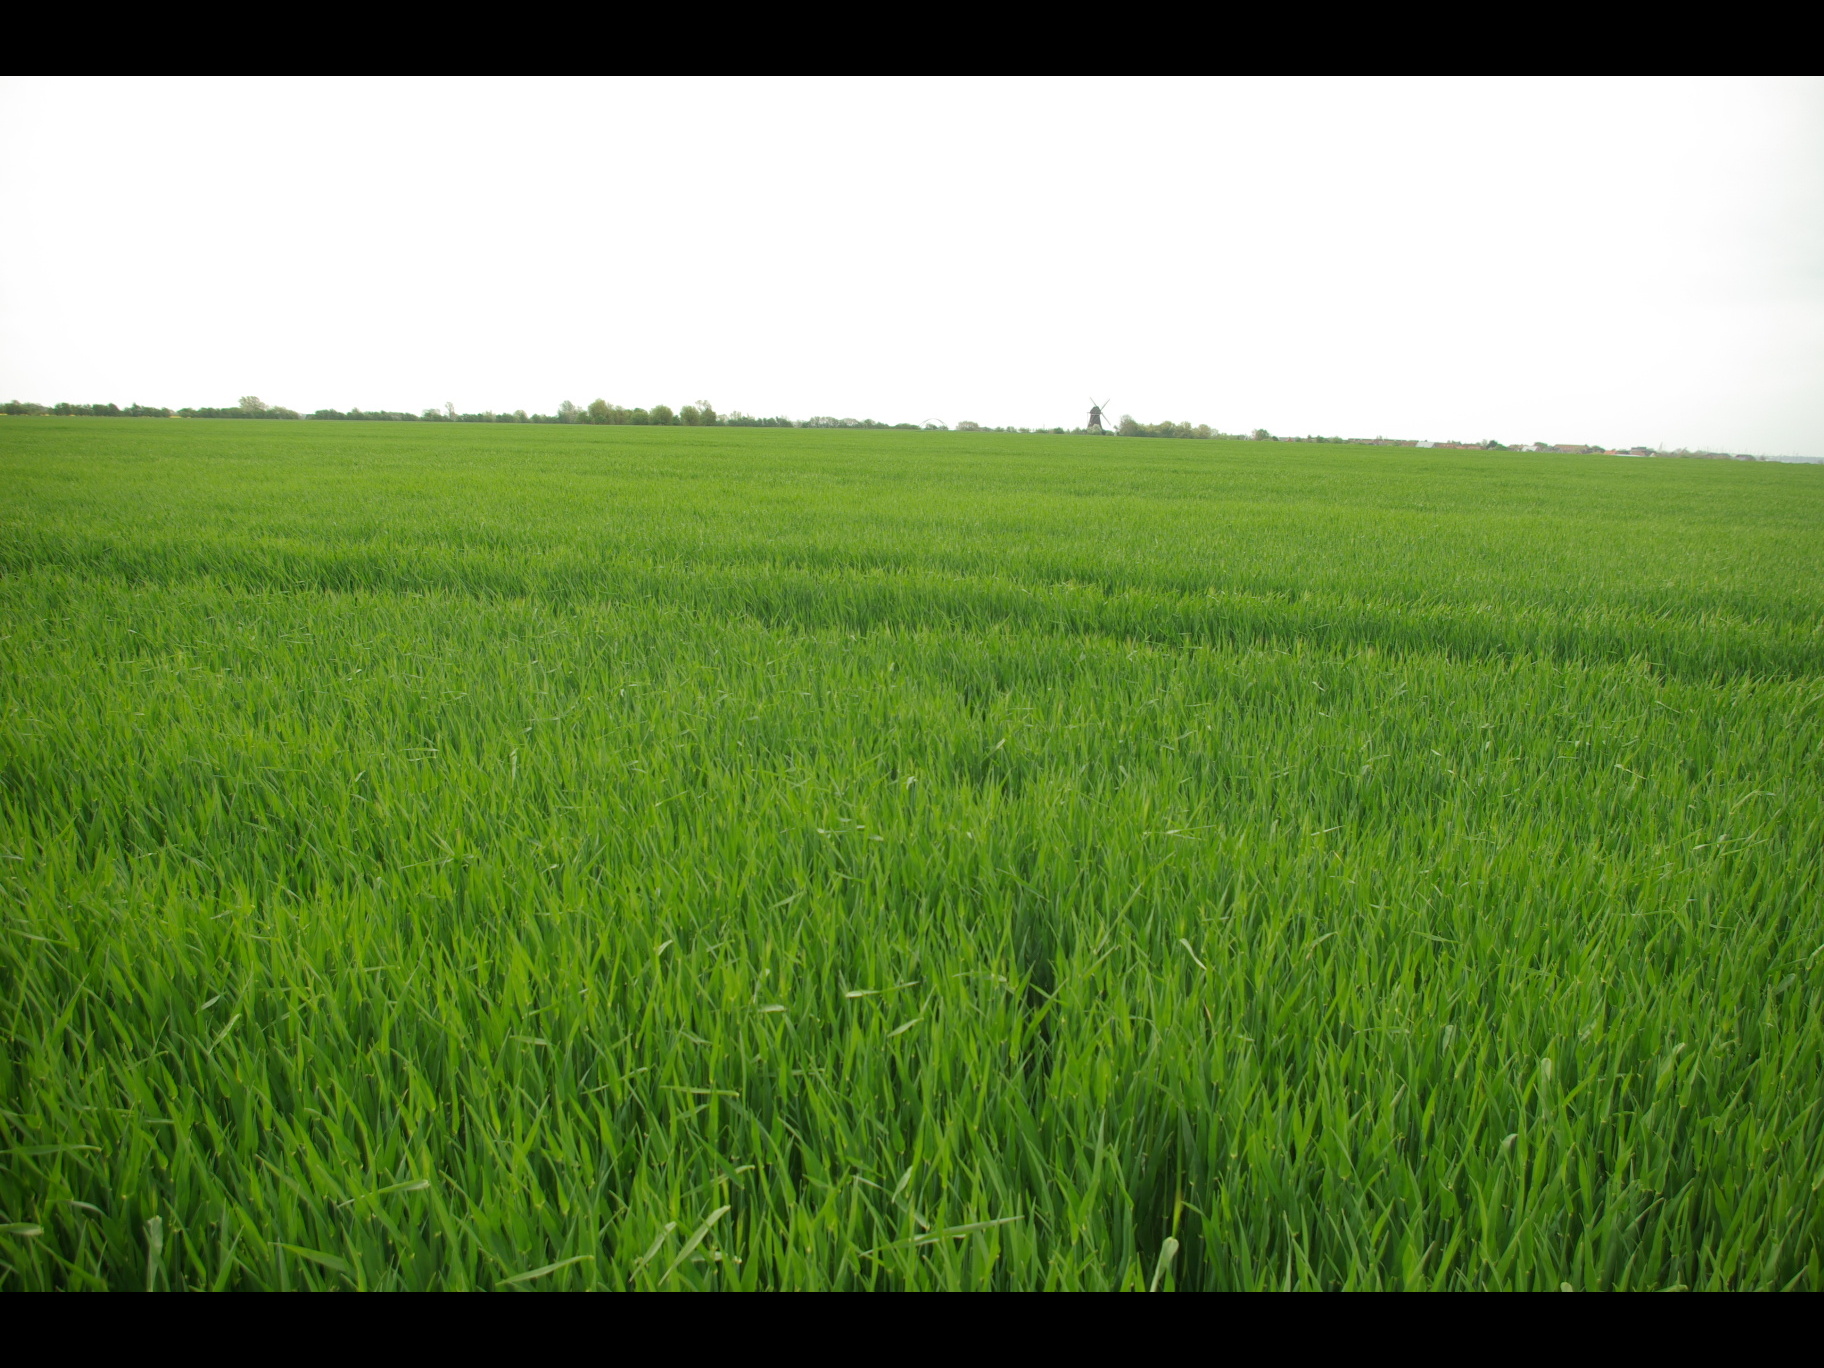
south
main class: Cropland
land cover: Barley
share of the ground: > 75 %
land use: Agriculture (excluding fallow land and kitchen gardens)
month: May
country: DE
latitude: 54.4574
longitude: 11.0945
